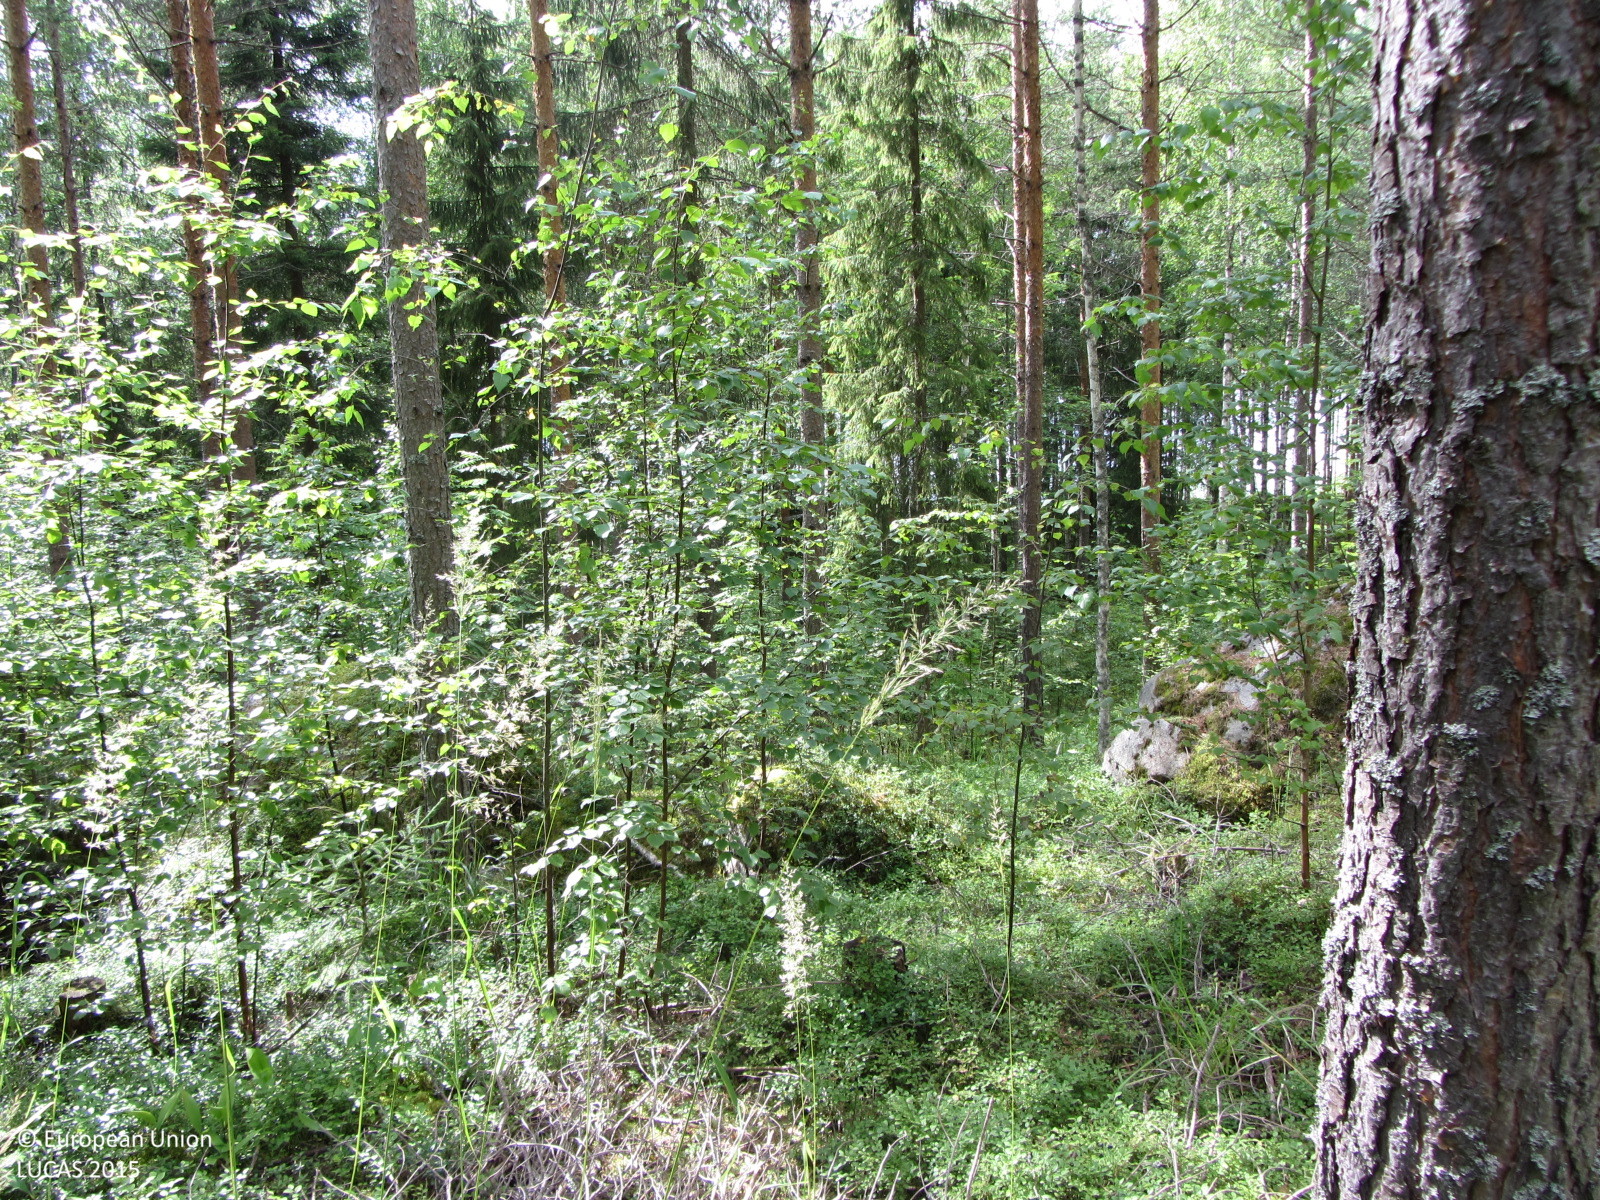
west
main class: Woodland
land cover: Pine dominated mixed woodland
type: boreal forest
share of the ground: > 75 %
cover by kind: coniferous forest trees 60 %, broadleaved forest trees 20 %, shrubs 10 %, herbaceous plants 10 %
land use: Forestry
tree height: > 5 m
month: July
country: FI
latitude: 60.6868
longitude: 24.5534
